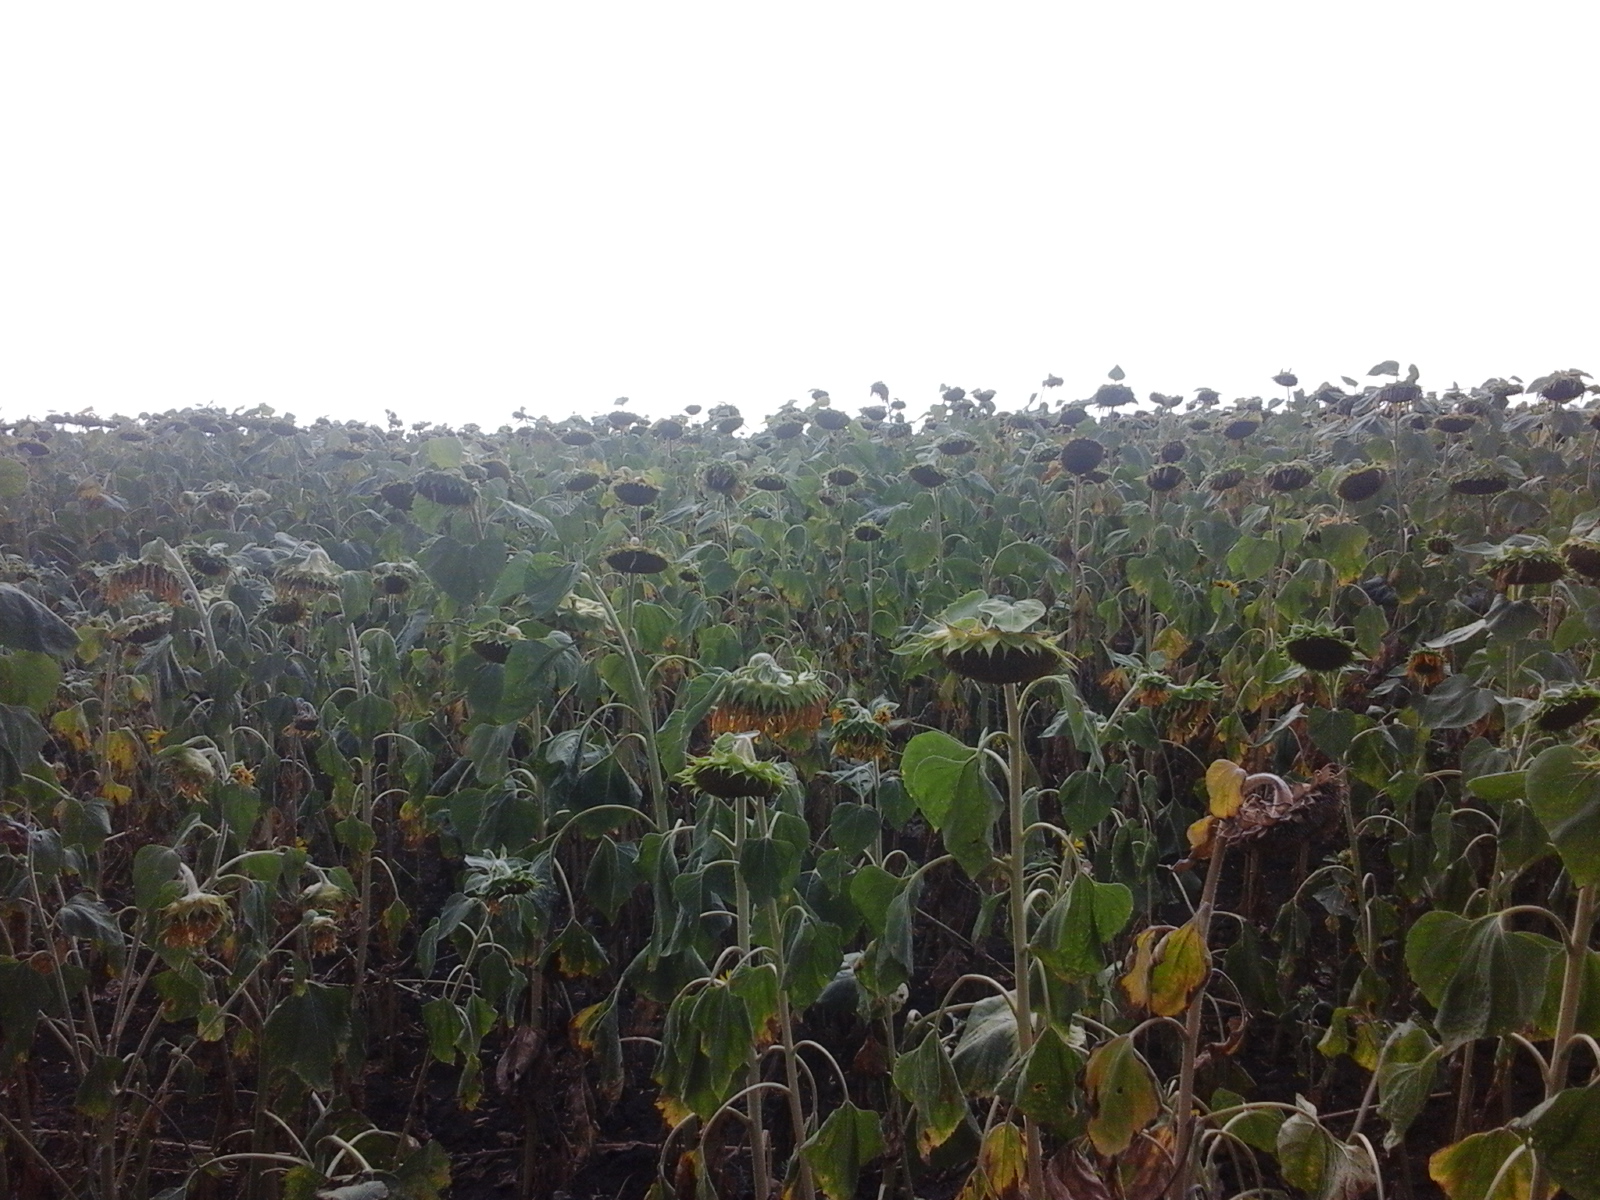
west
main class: Cropland
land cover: Sunflower
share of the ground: > 75 %
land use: Agriculture (excluding fallow land and kitchen gardens)
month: August
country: RO
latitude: 44.1234
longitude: 23.4840
